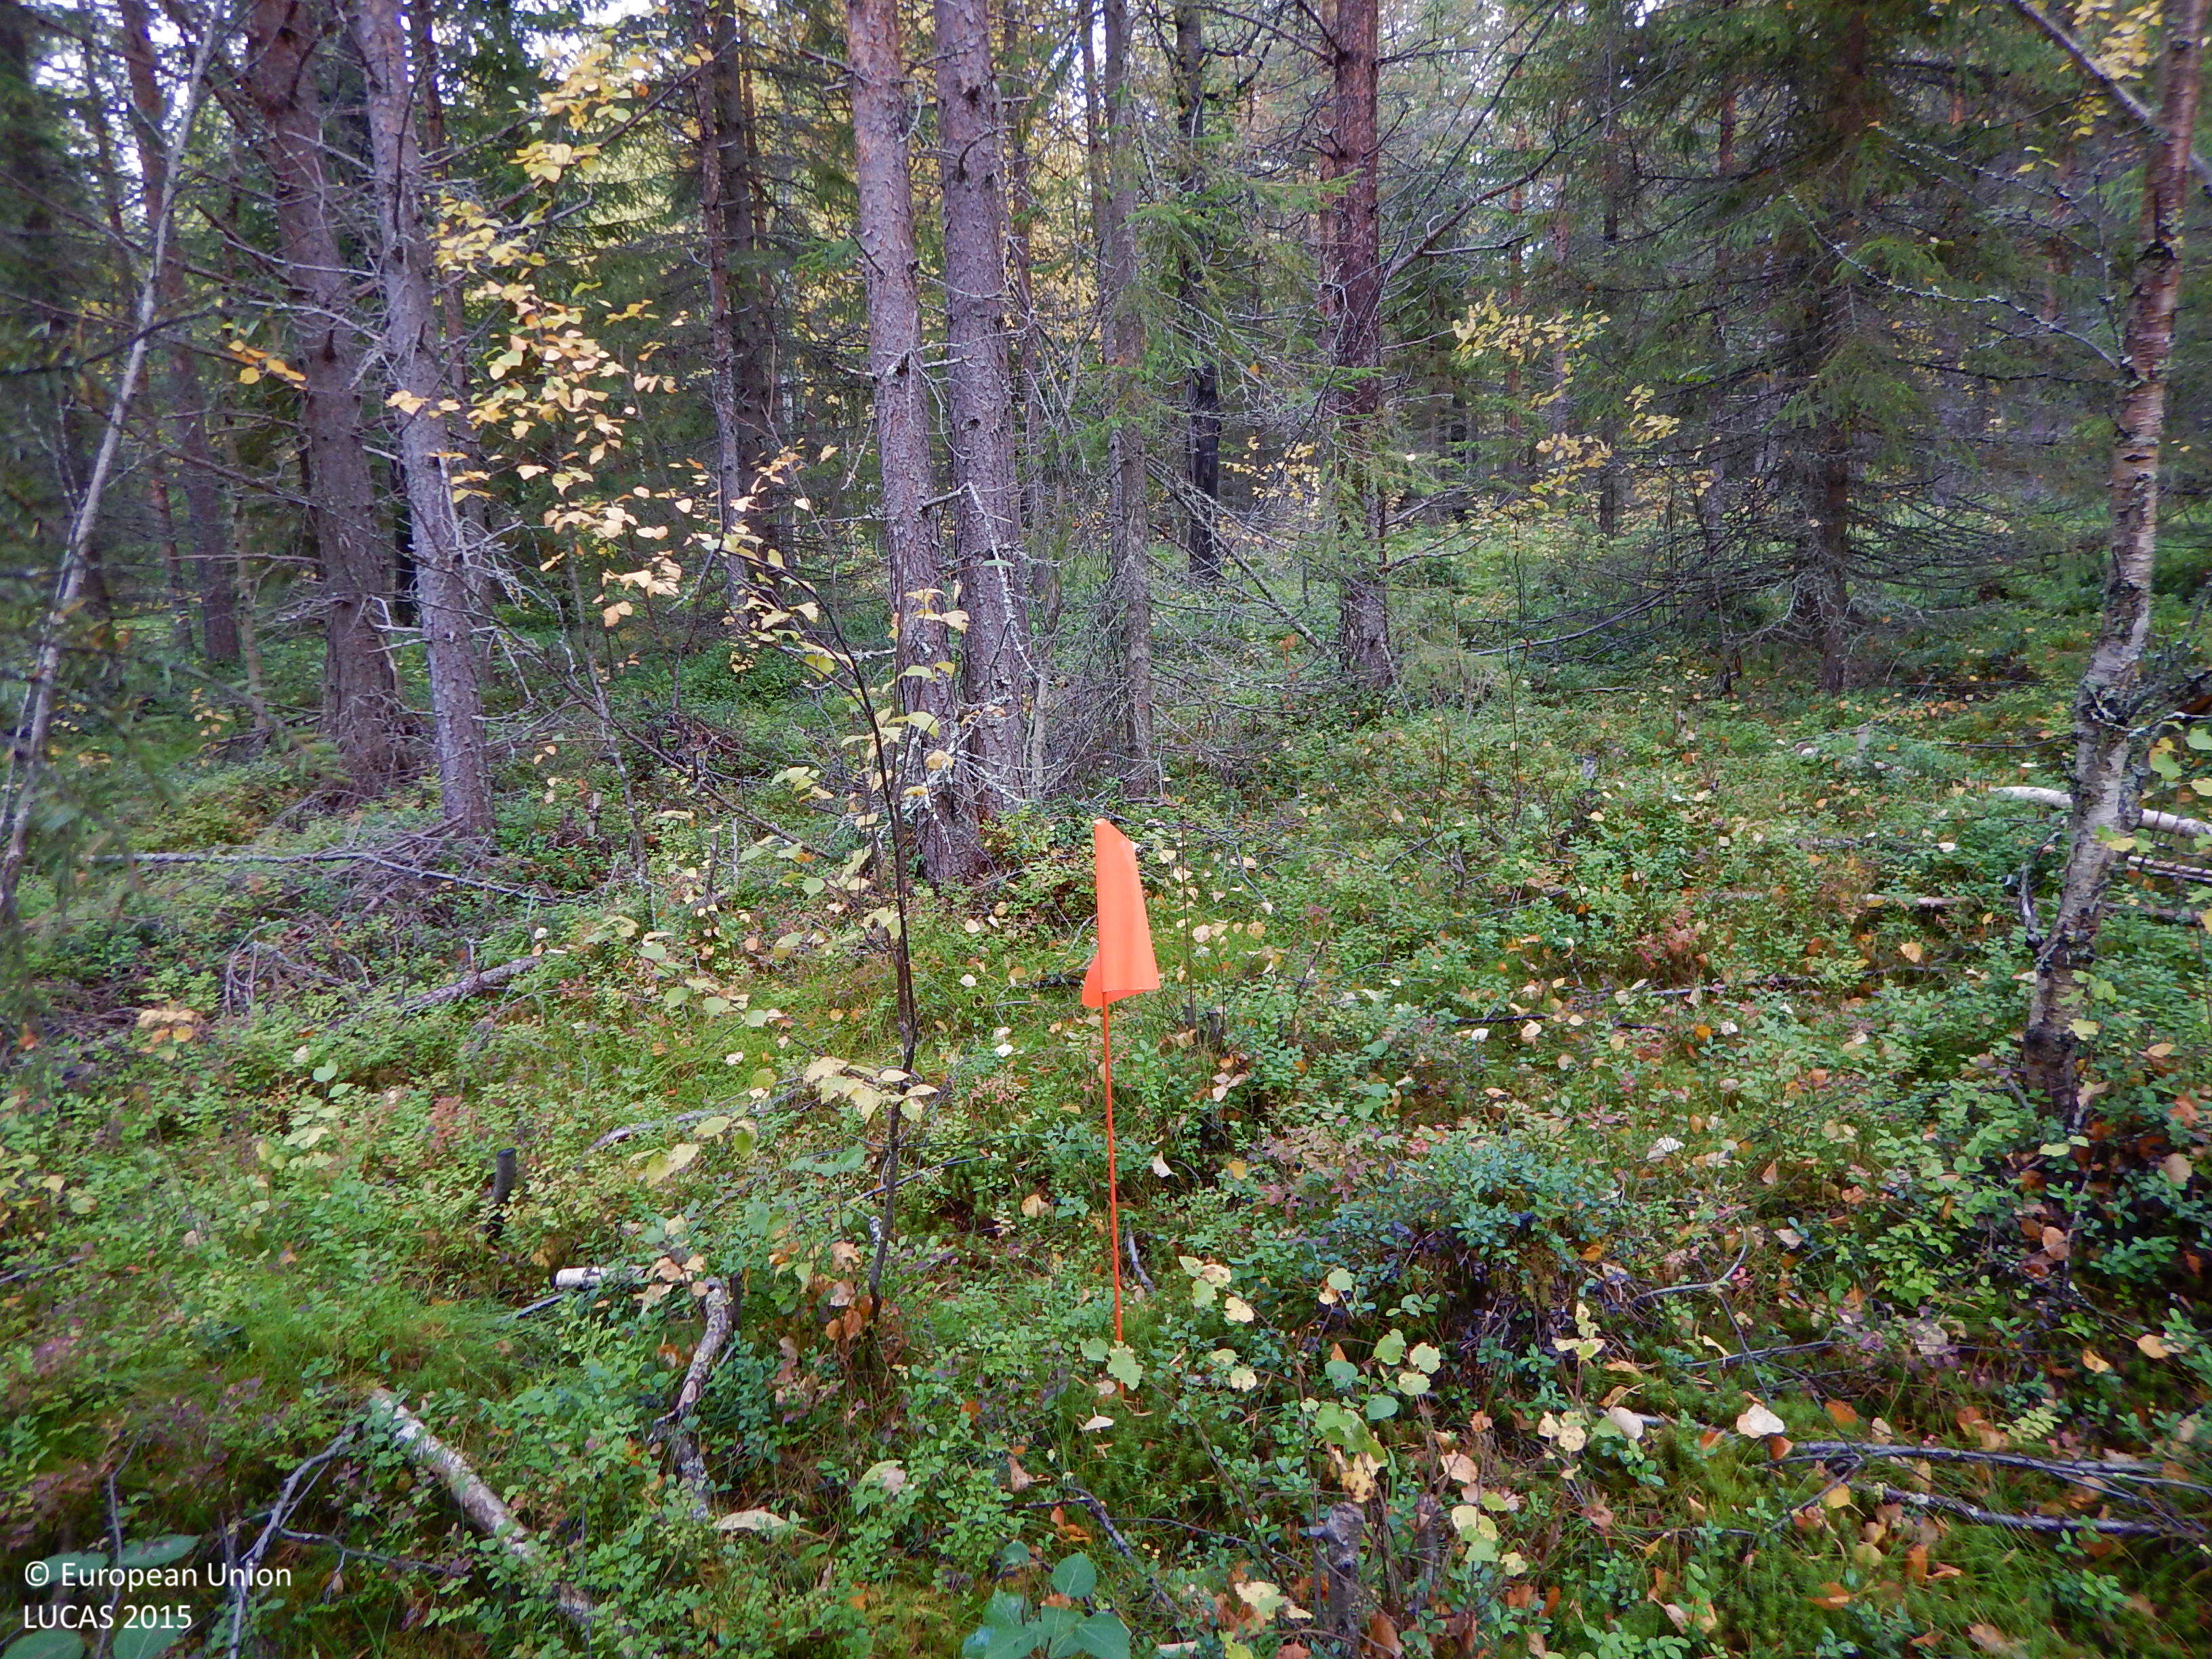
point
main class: Woodland
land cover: Other coniferous woodland
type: boreal forest
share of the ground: 50 - 75 %
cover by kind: coniferous forest trees 60 %, shrubs 15 %, herbaceous plants 10 %, lichens and mosses 10 %, broadleaved forest trees 5 %
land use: Forestry
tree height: > 5 m
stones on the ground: < 10 %
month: September
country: SE
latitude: 64.8001
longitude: 19.8850
